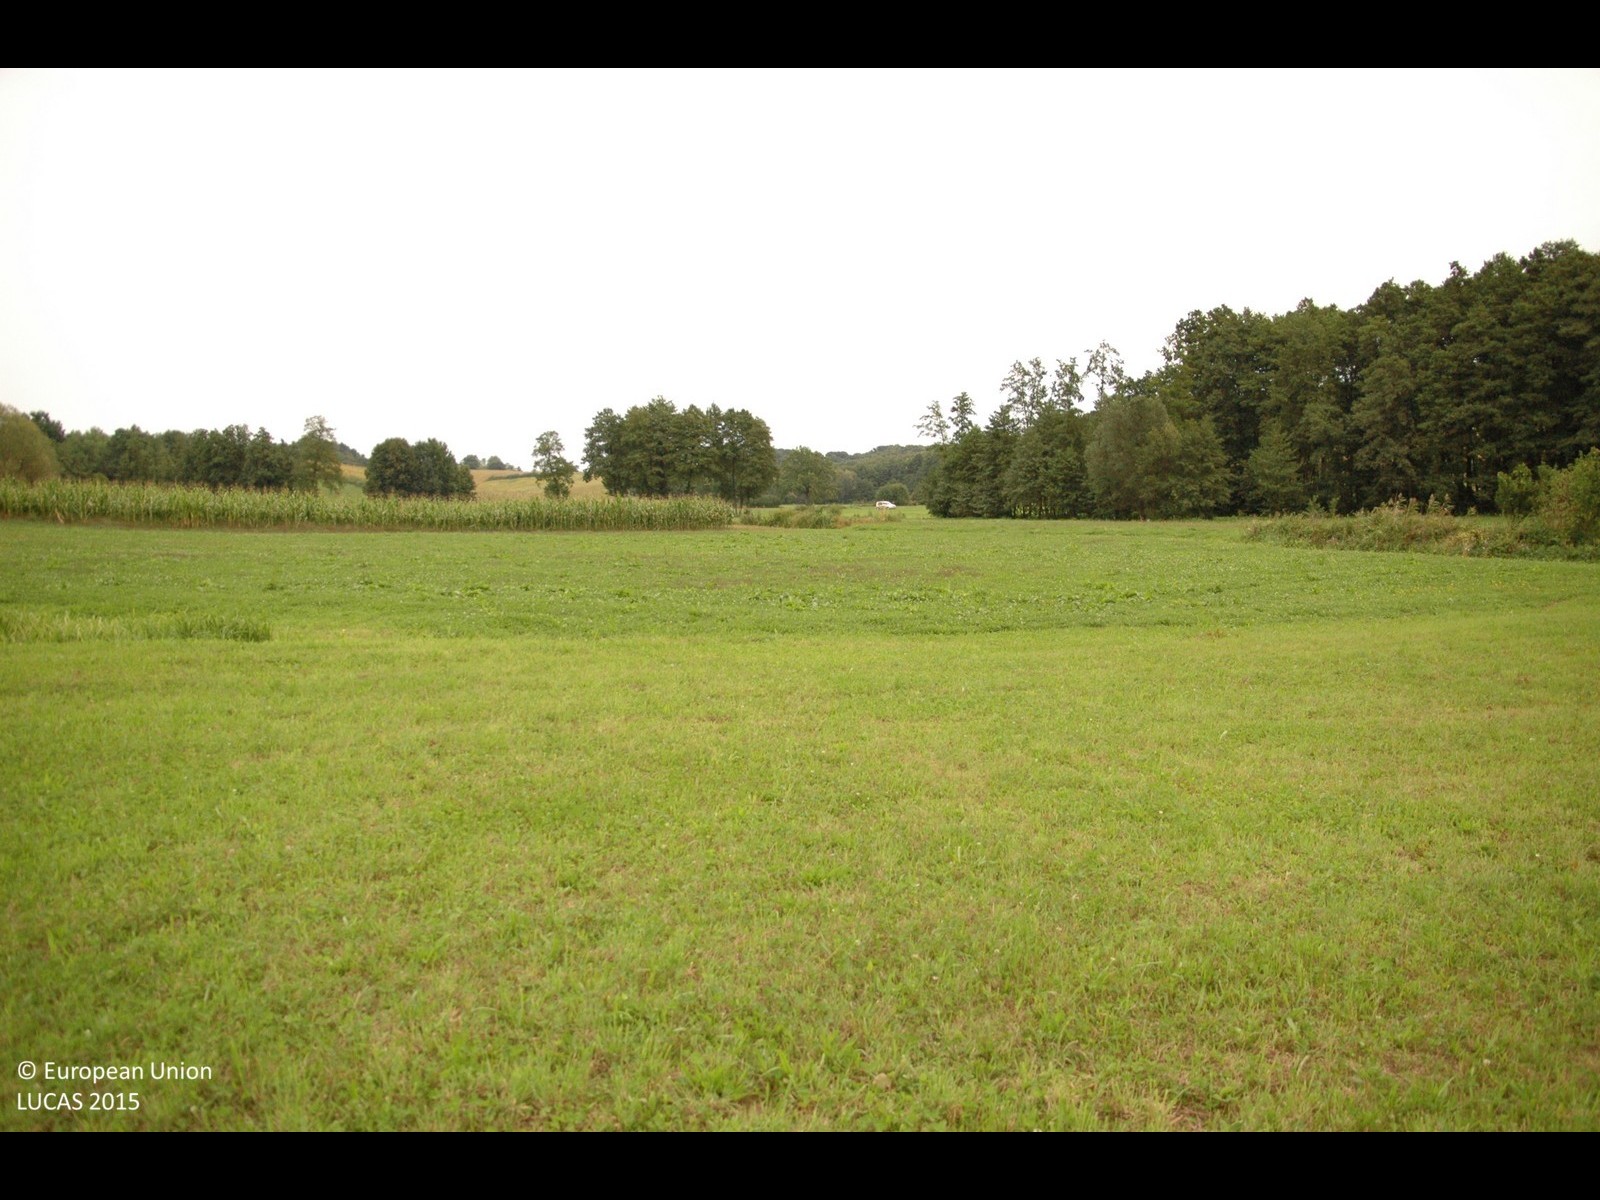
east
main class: Grassland
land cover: Grassland without tree/shrub cover
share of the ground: > 75 %
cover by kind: herbaceous plants 100 %
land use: Agriculture (excluding fallow land and kitchen gardens)
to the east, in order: Grassland without tree/shrub cover; Tracks; Grassland without tree/shrub cover; Tracks; Abandoned hedges; Ditches and canals; Abandoned hedges; Grassland without tree/shrub cover; Abandoned hedges; Ditches and canals; Abandoned hedges; Tracks; Grassland without tree/shrub cover
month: September
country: HR
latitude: 46.0649
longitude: 16.7618
